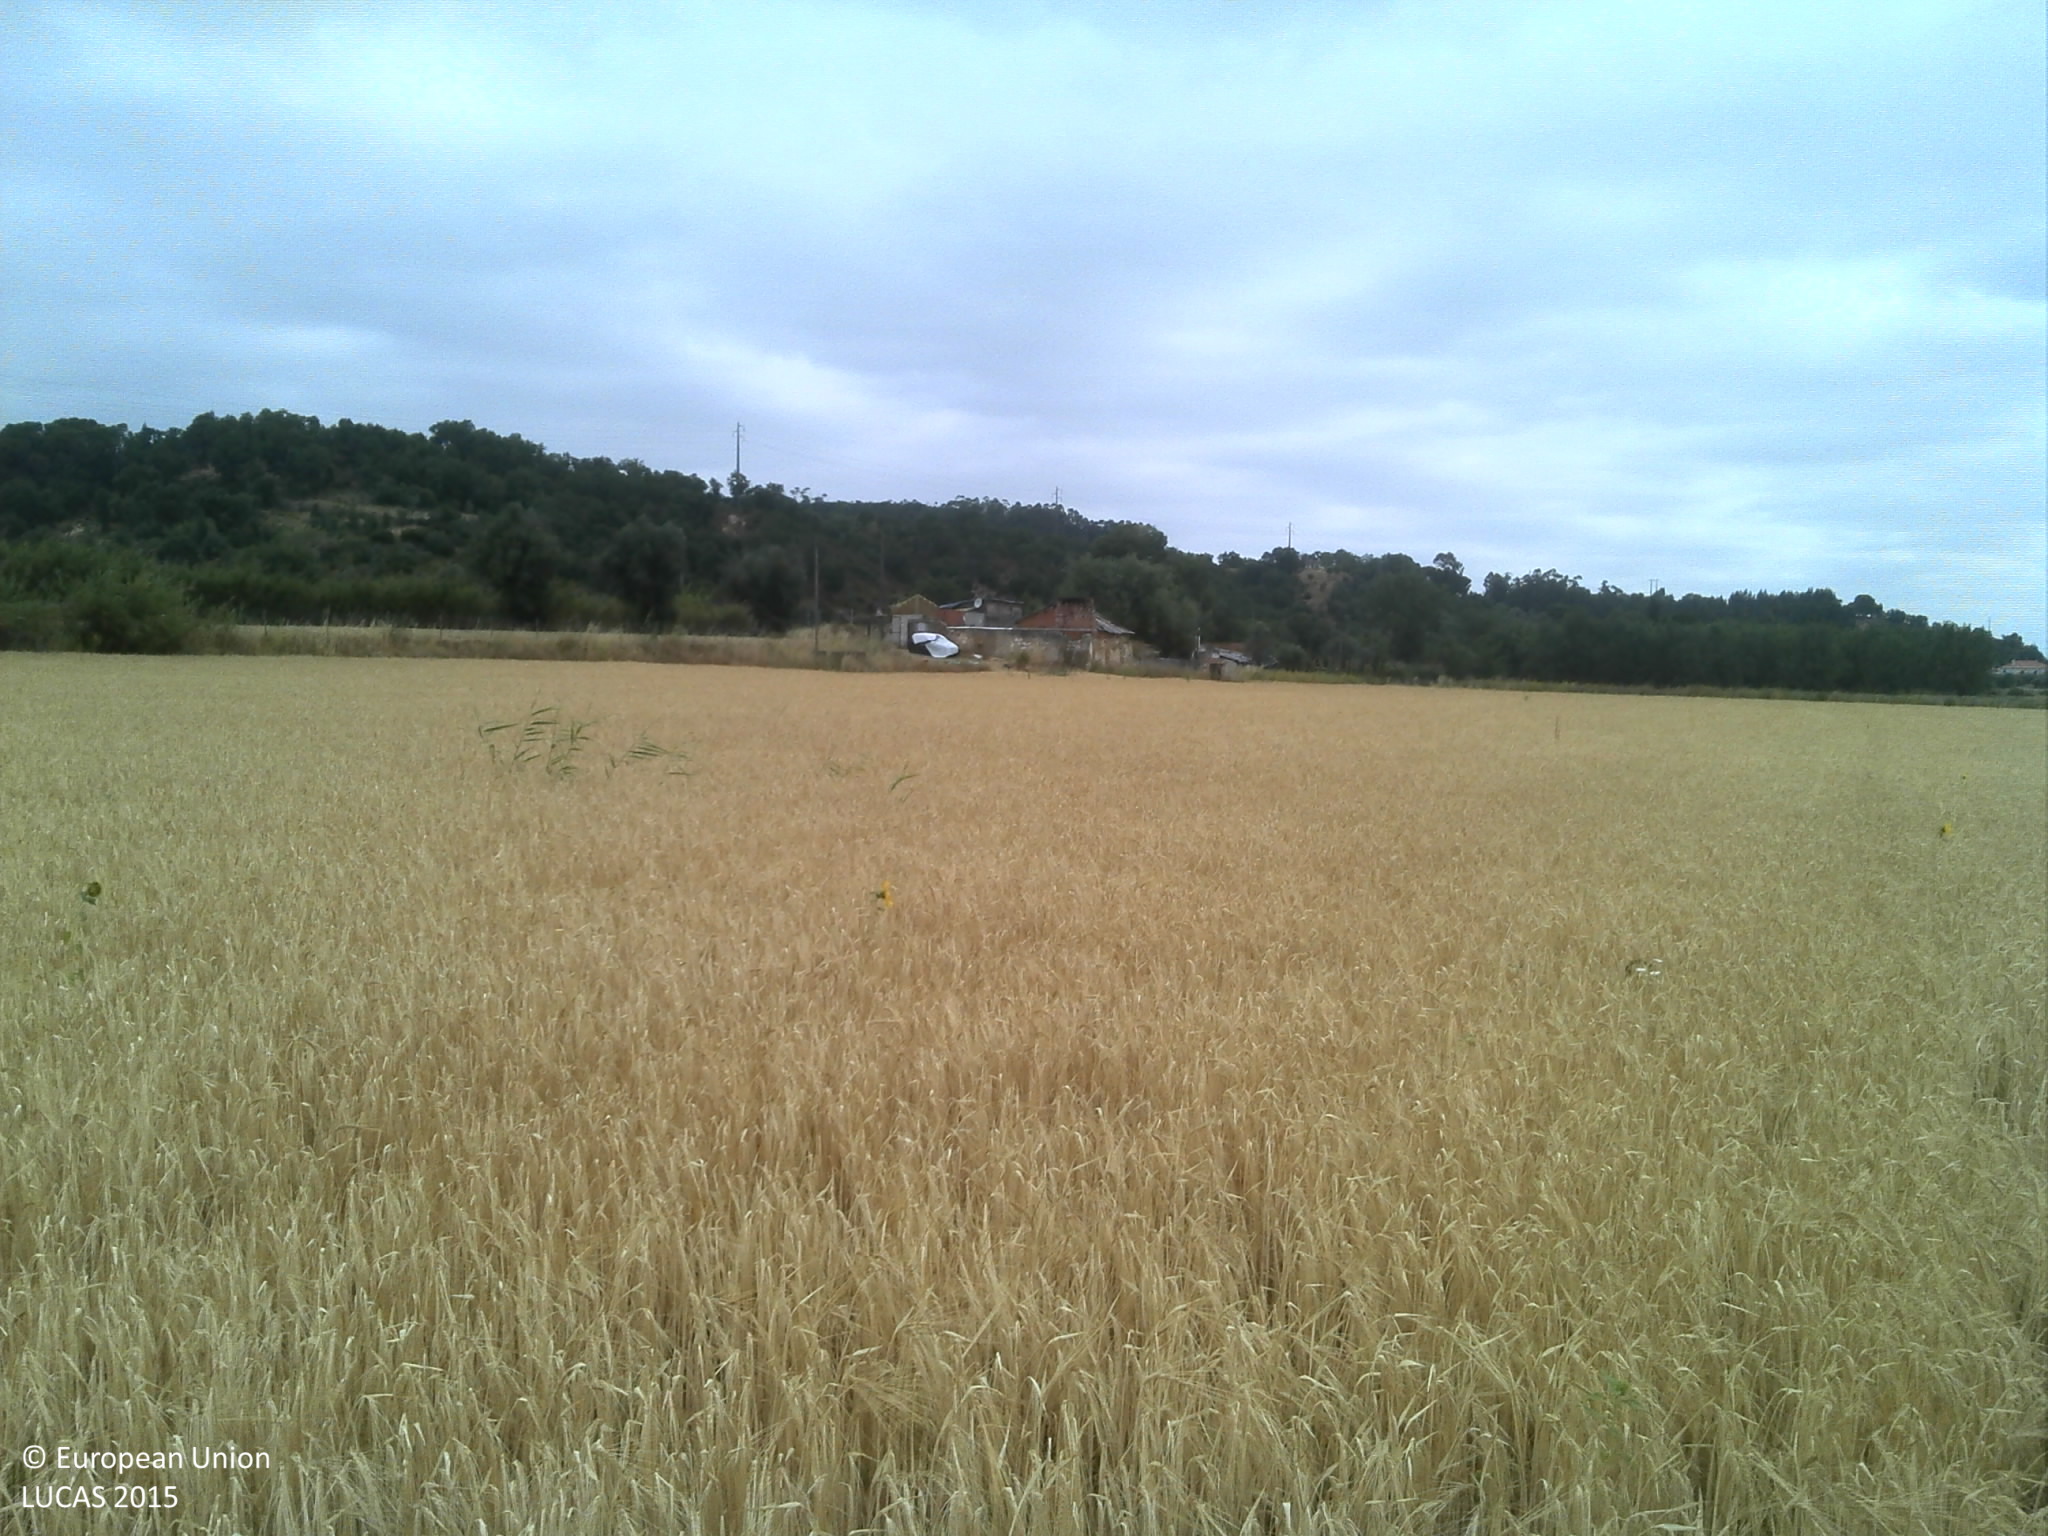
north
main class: Cropland
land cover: Common wheat
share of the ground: > 75 %
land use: Agriculture (excluding fallow land and kitchen gardens)
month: June
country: PT
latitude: 39.2528
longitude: -8.6713
